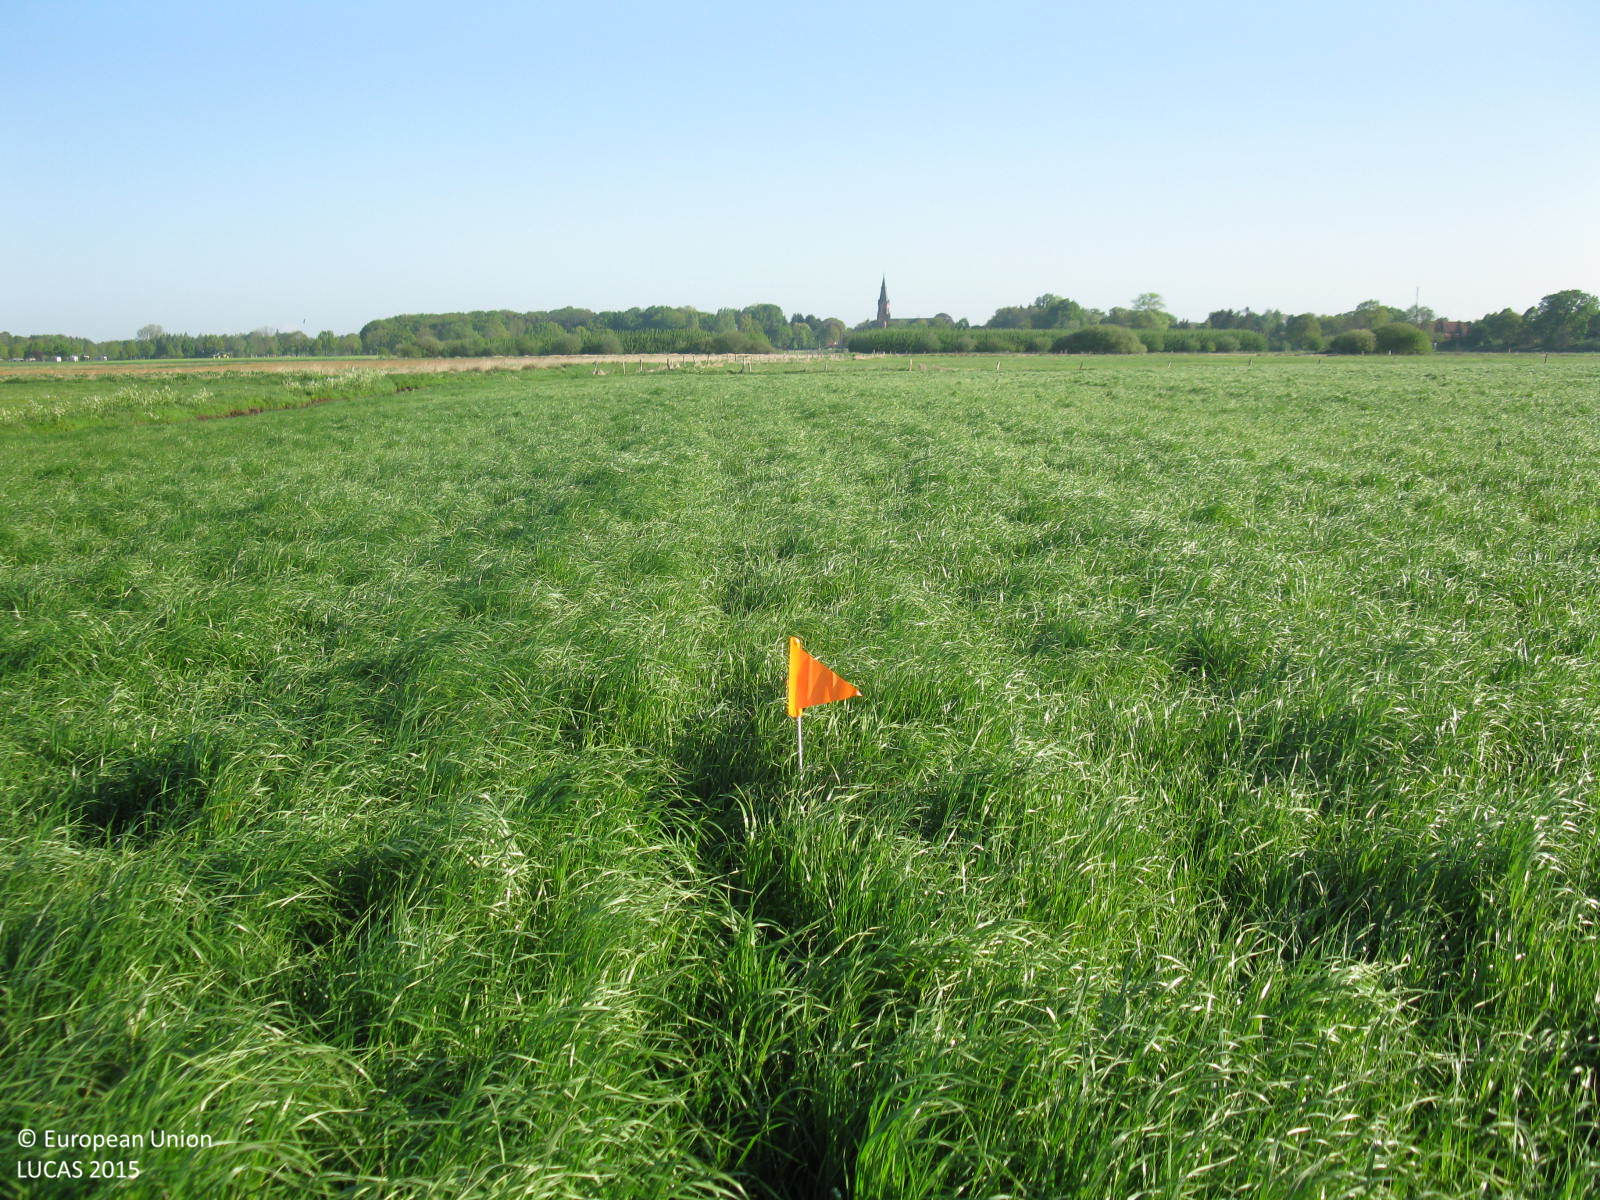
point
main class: Grassland
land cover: Grassland without tree/shrub cover
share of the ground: > 75 %
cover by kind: herbaceous plants 100 %
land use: Agriculture (excluding fallow land and kitchen gardens)
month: May
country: DE
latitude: 52.8506
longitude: 7.3127
